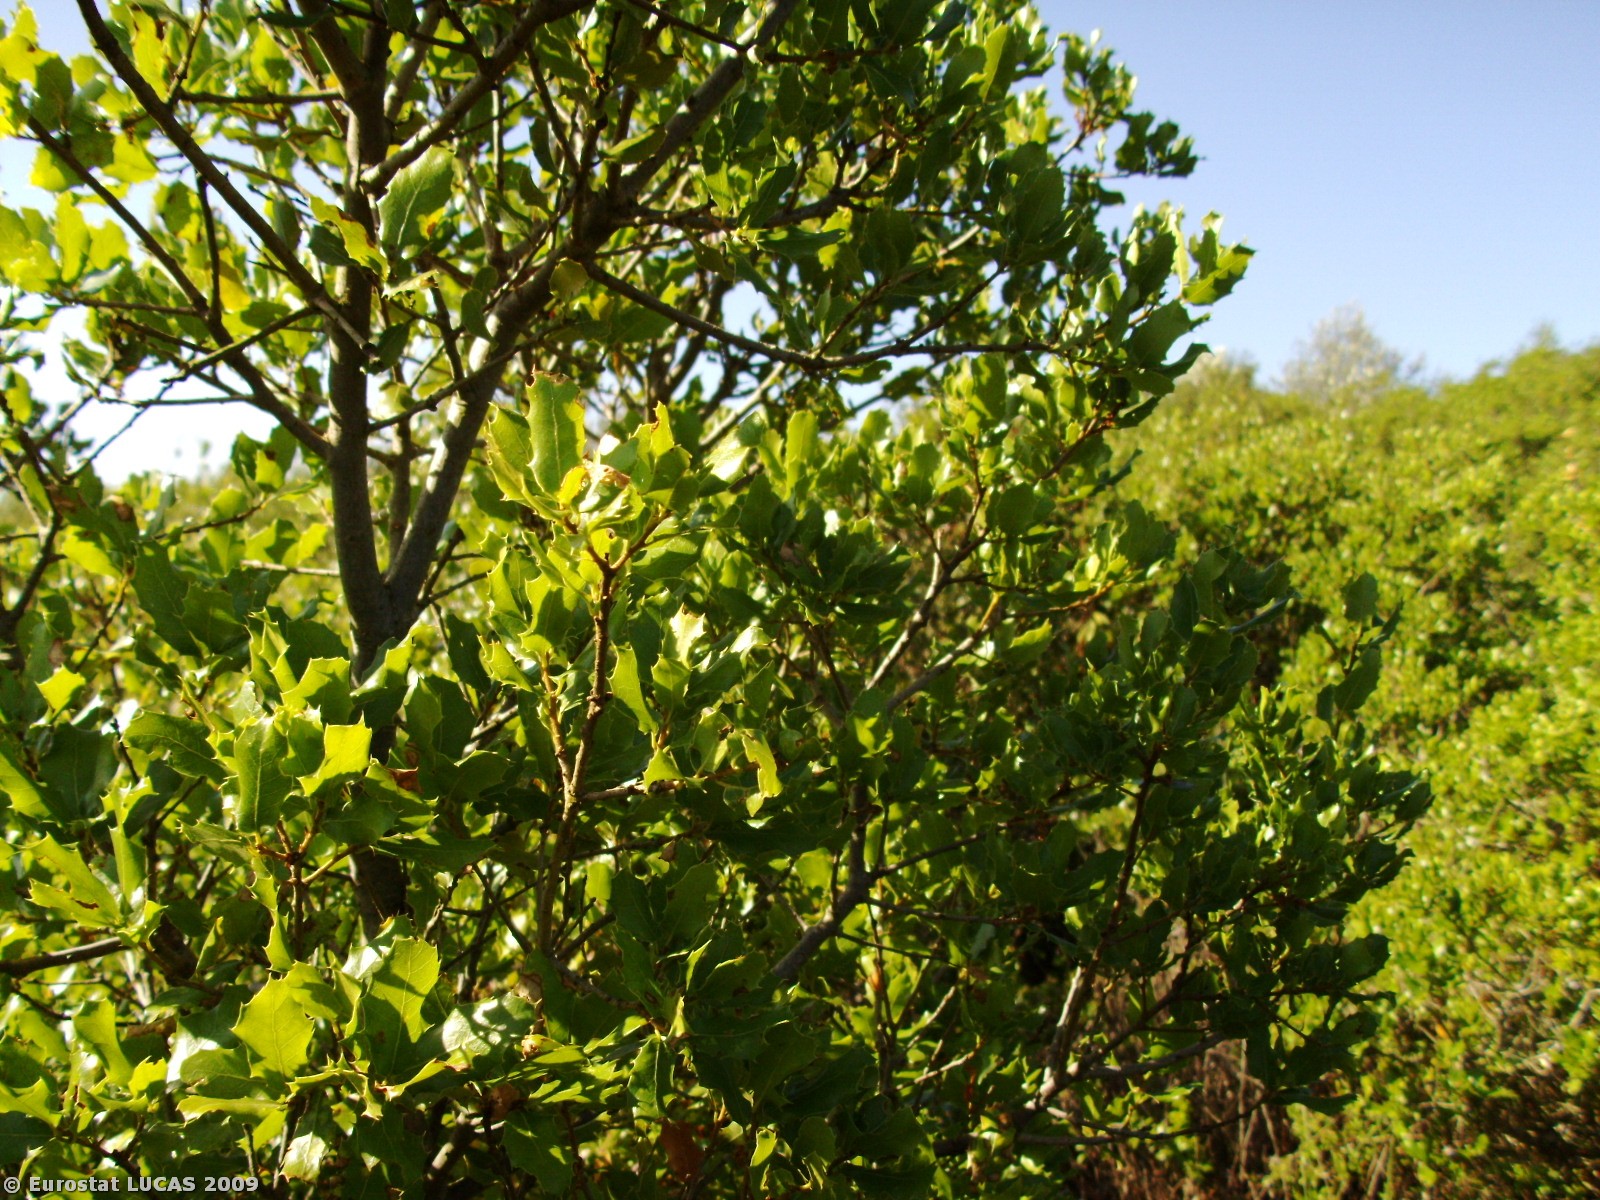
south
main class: Shrubland
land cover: Shrubland with sparse tree cover
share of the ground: > 75 %
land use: Unused
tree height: > 5 m
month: June
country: PT
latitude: 39.9928
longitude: -8.3844
